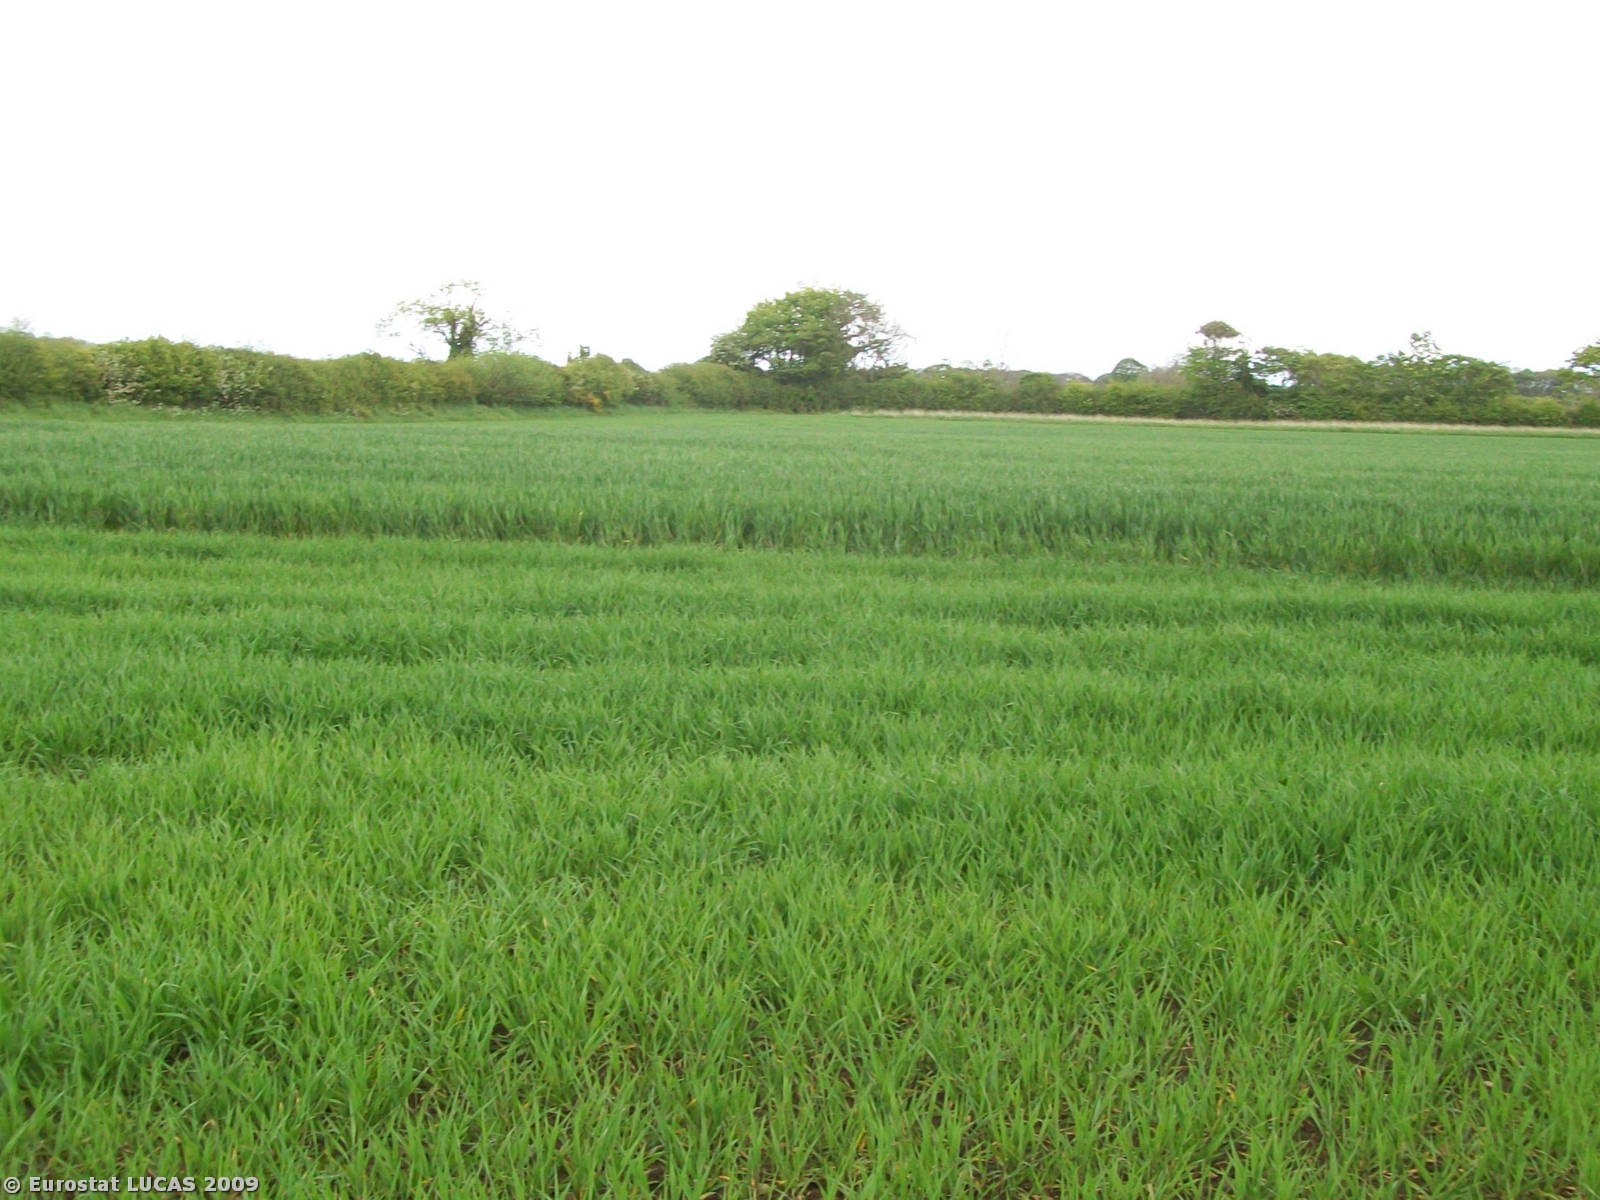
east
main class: Cropland
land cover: Barley
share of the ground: < 10 %
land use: Agriculture (excluding fallow land and kitchen gardens)
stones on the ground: < 10 %
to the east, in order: Barley; Managed hedges; Barley
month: May
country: GB
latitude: 54.5656
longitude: -1.6344
